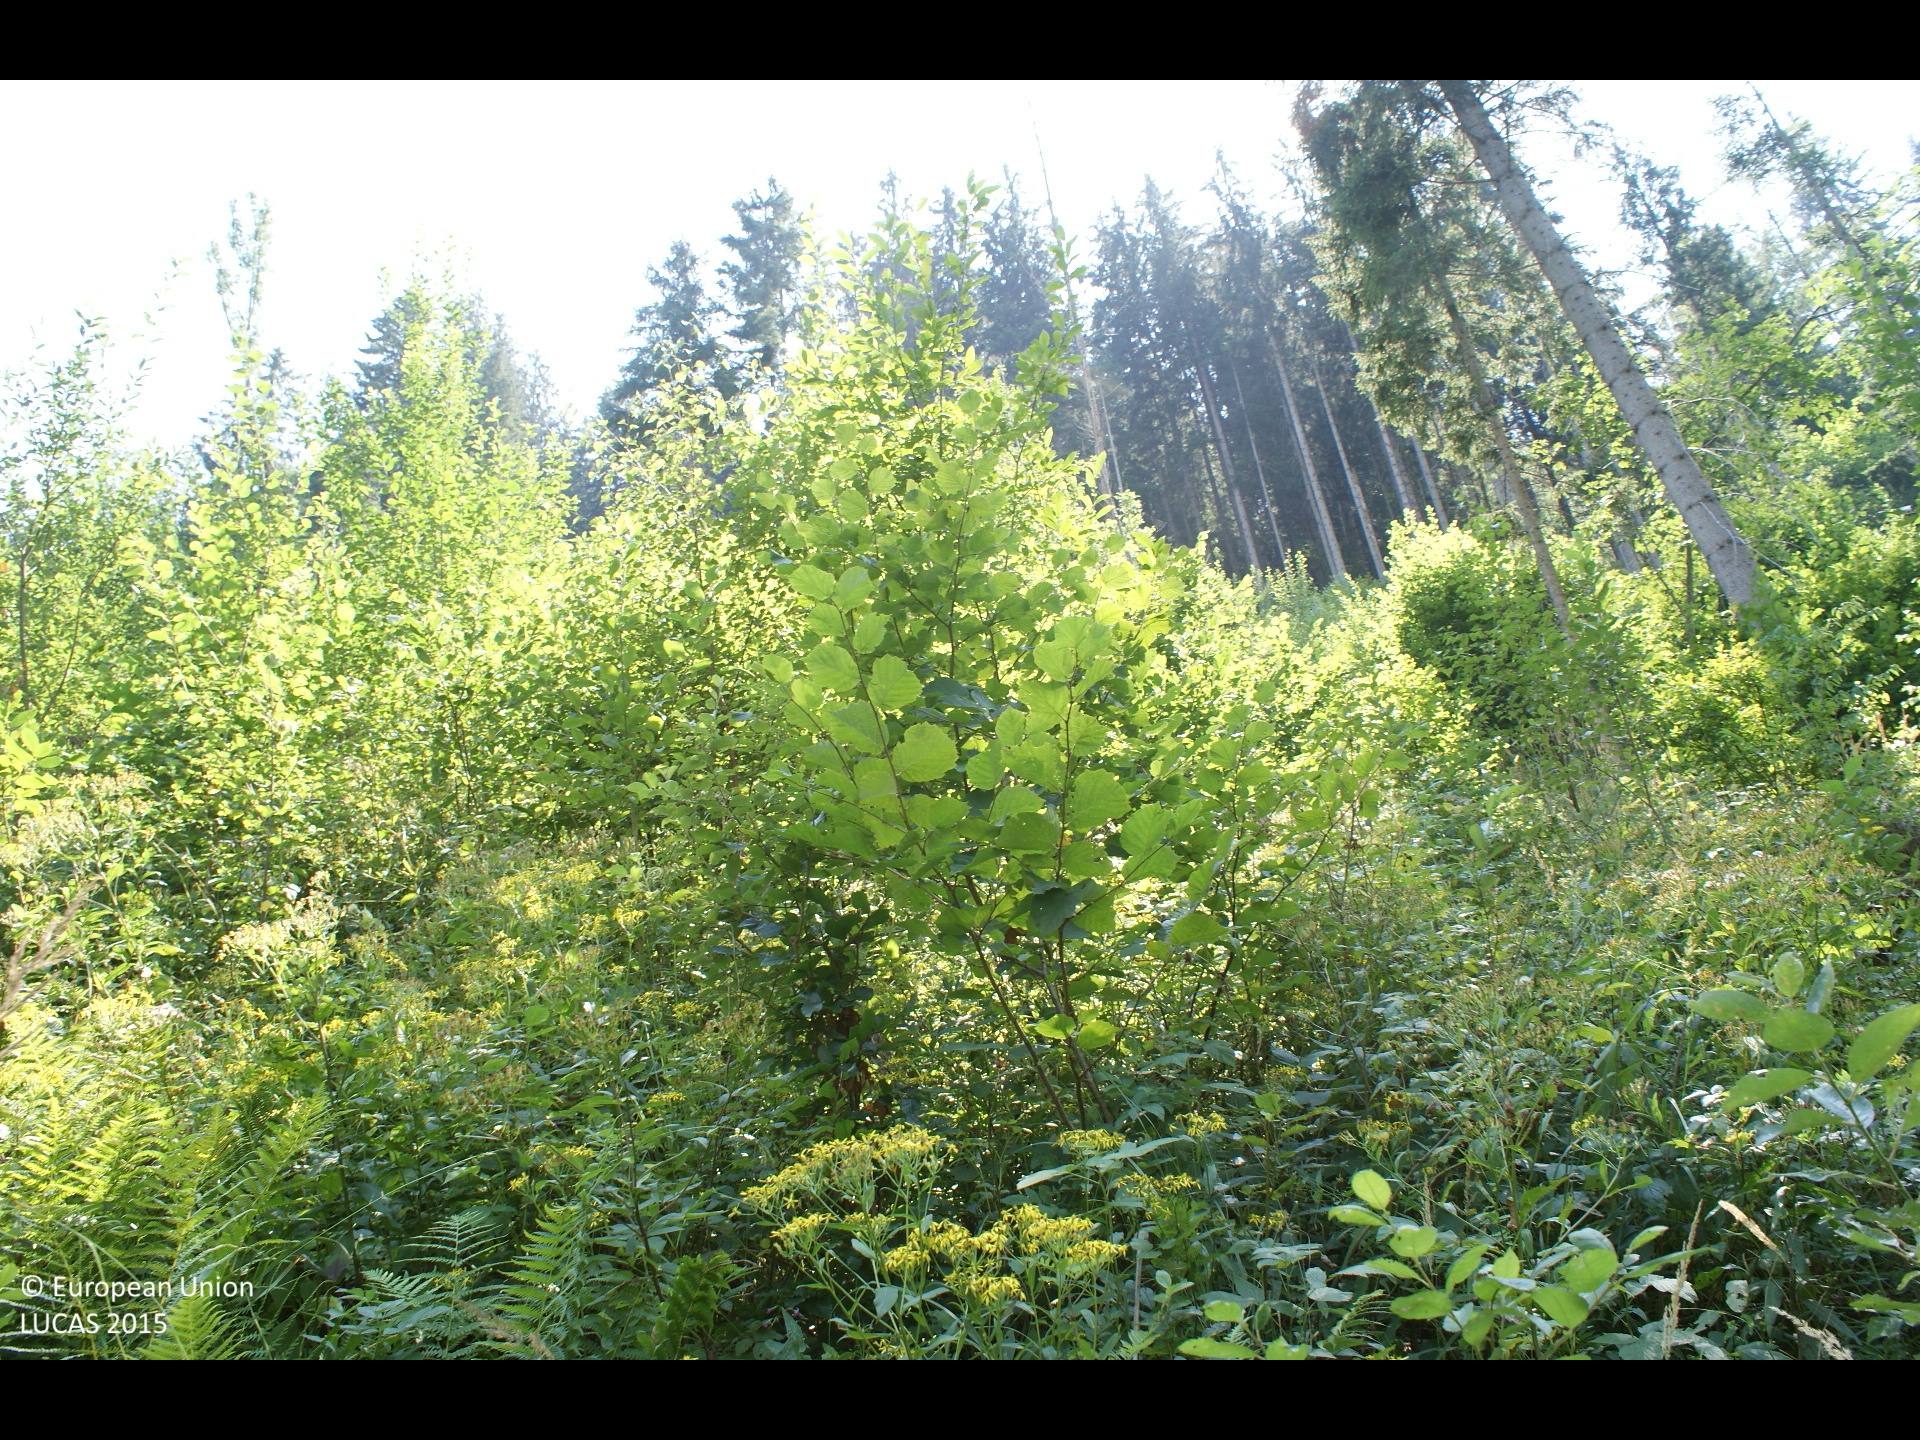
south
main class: Shrubland
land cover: Shrubland with sparse tree cover
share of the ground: > 75 %
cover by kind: shrubs 75 %, herbaceous plants 20 %, broadleaved forest trees 5 %
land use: Forestry
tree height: < 5 m
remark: Clear cut
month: August
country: AT
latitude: 47.7151
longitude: 15.3462
